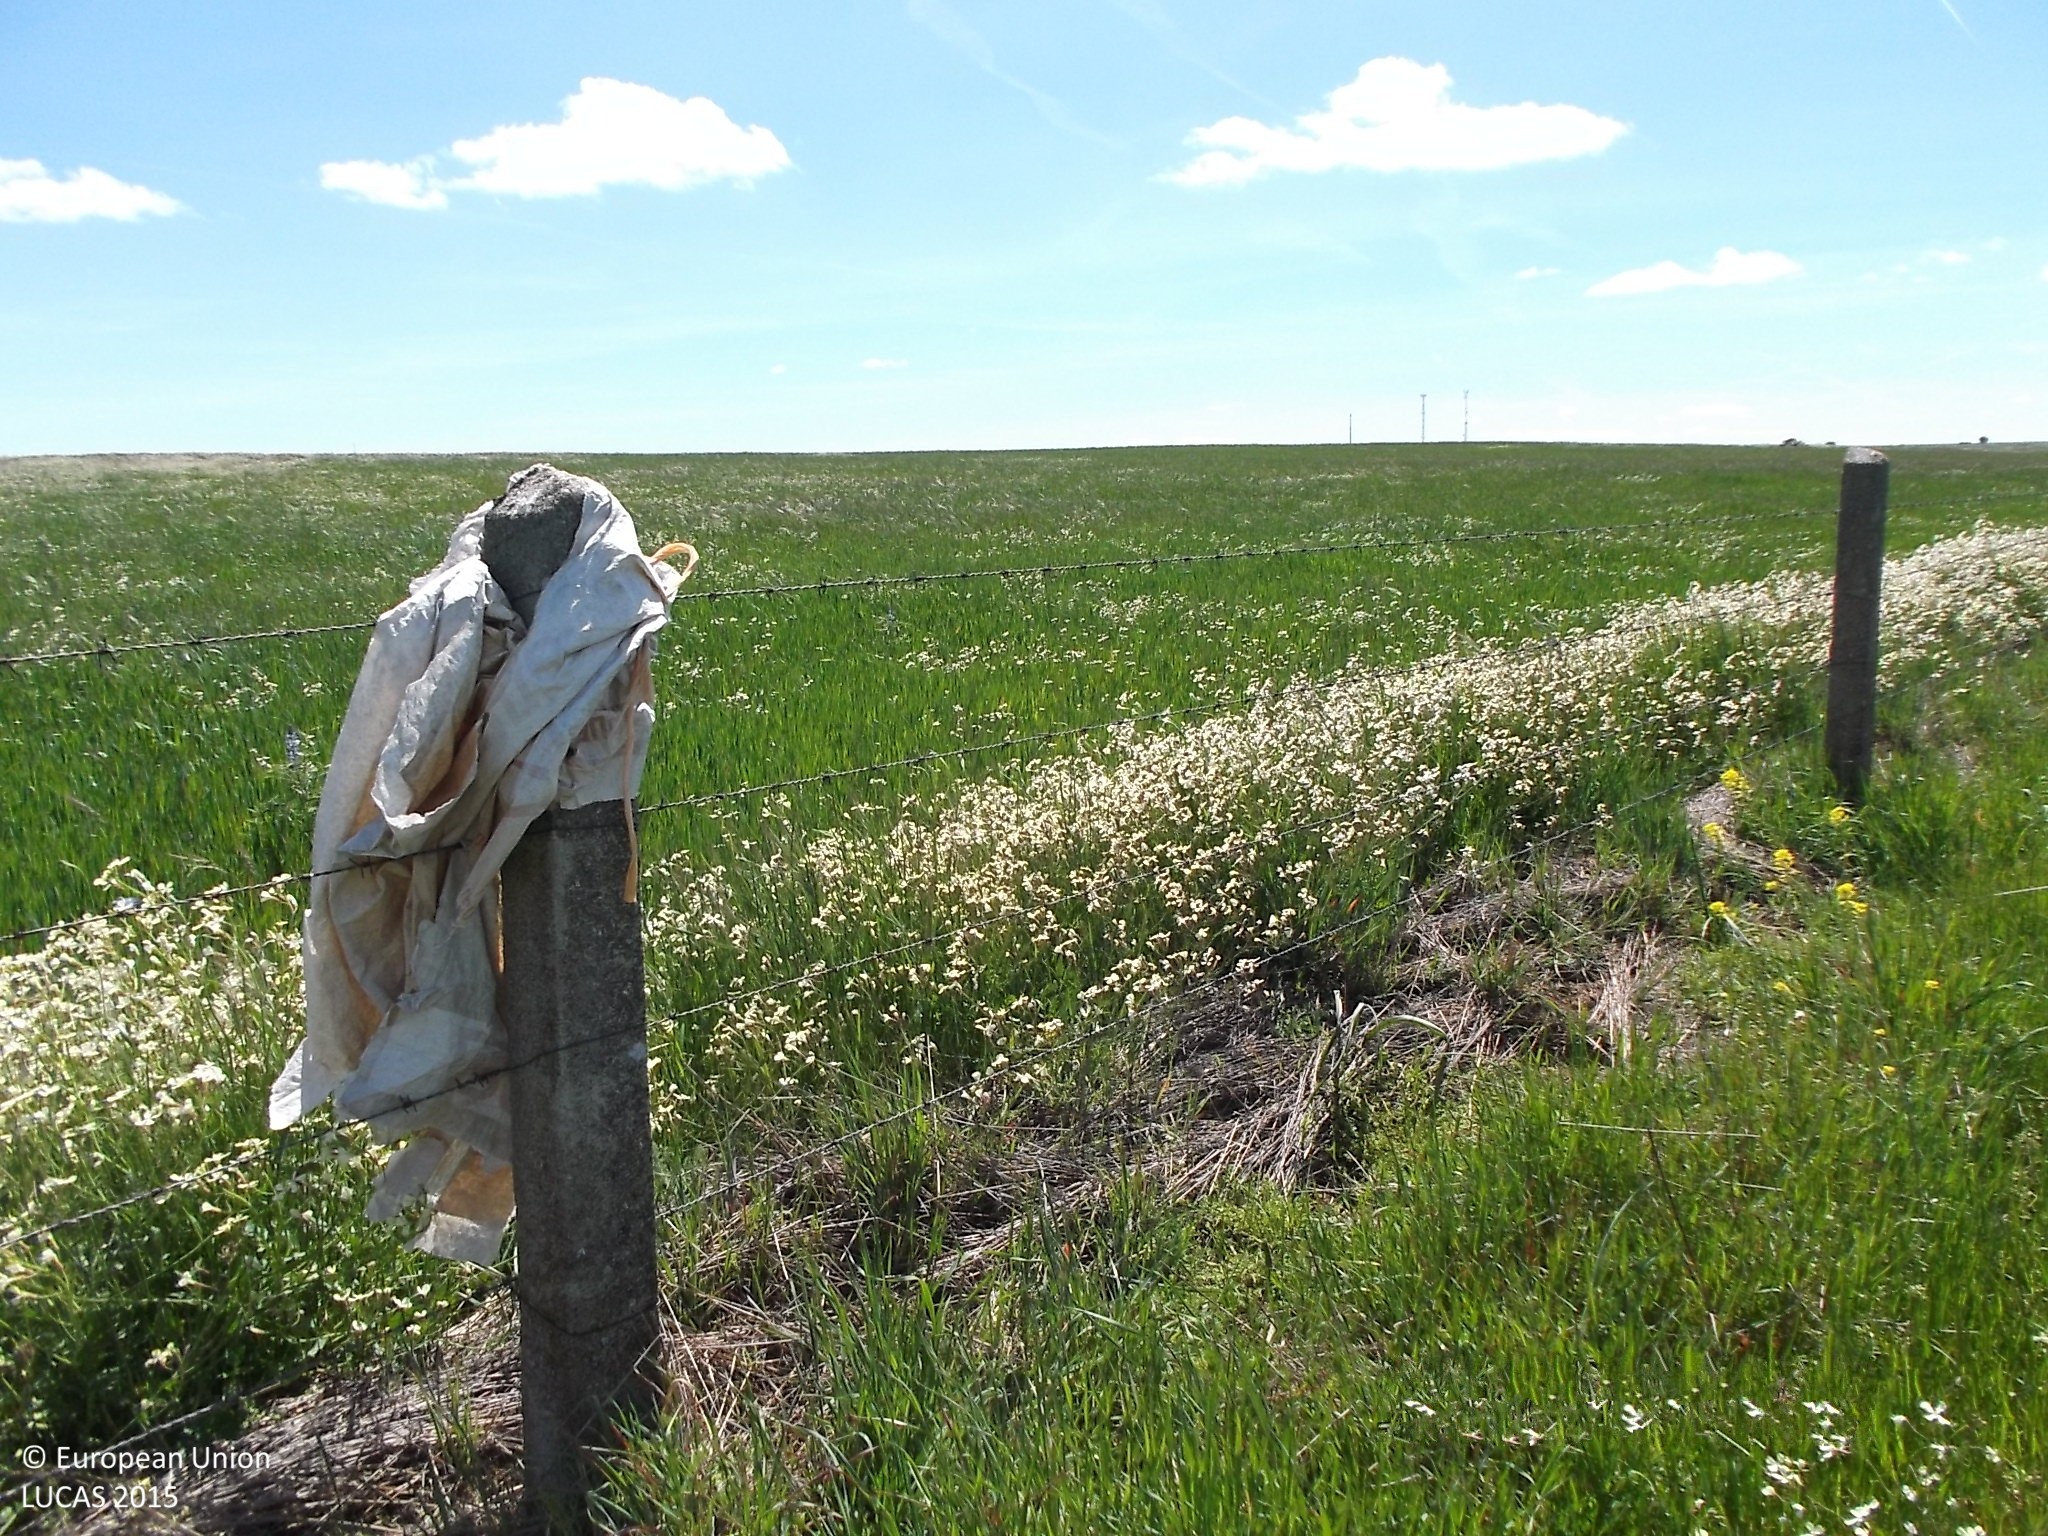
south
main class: Cropland
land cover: Mixed cereals for fodder
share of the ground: > 75 %
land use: Agriculture (excluding fallow land and kitchen gardens)
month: April
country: ES
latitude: 41.0256
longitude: -5.9857
